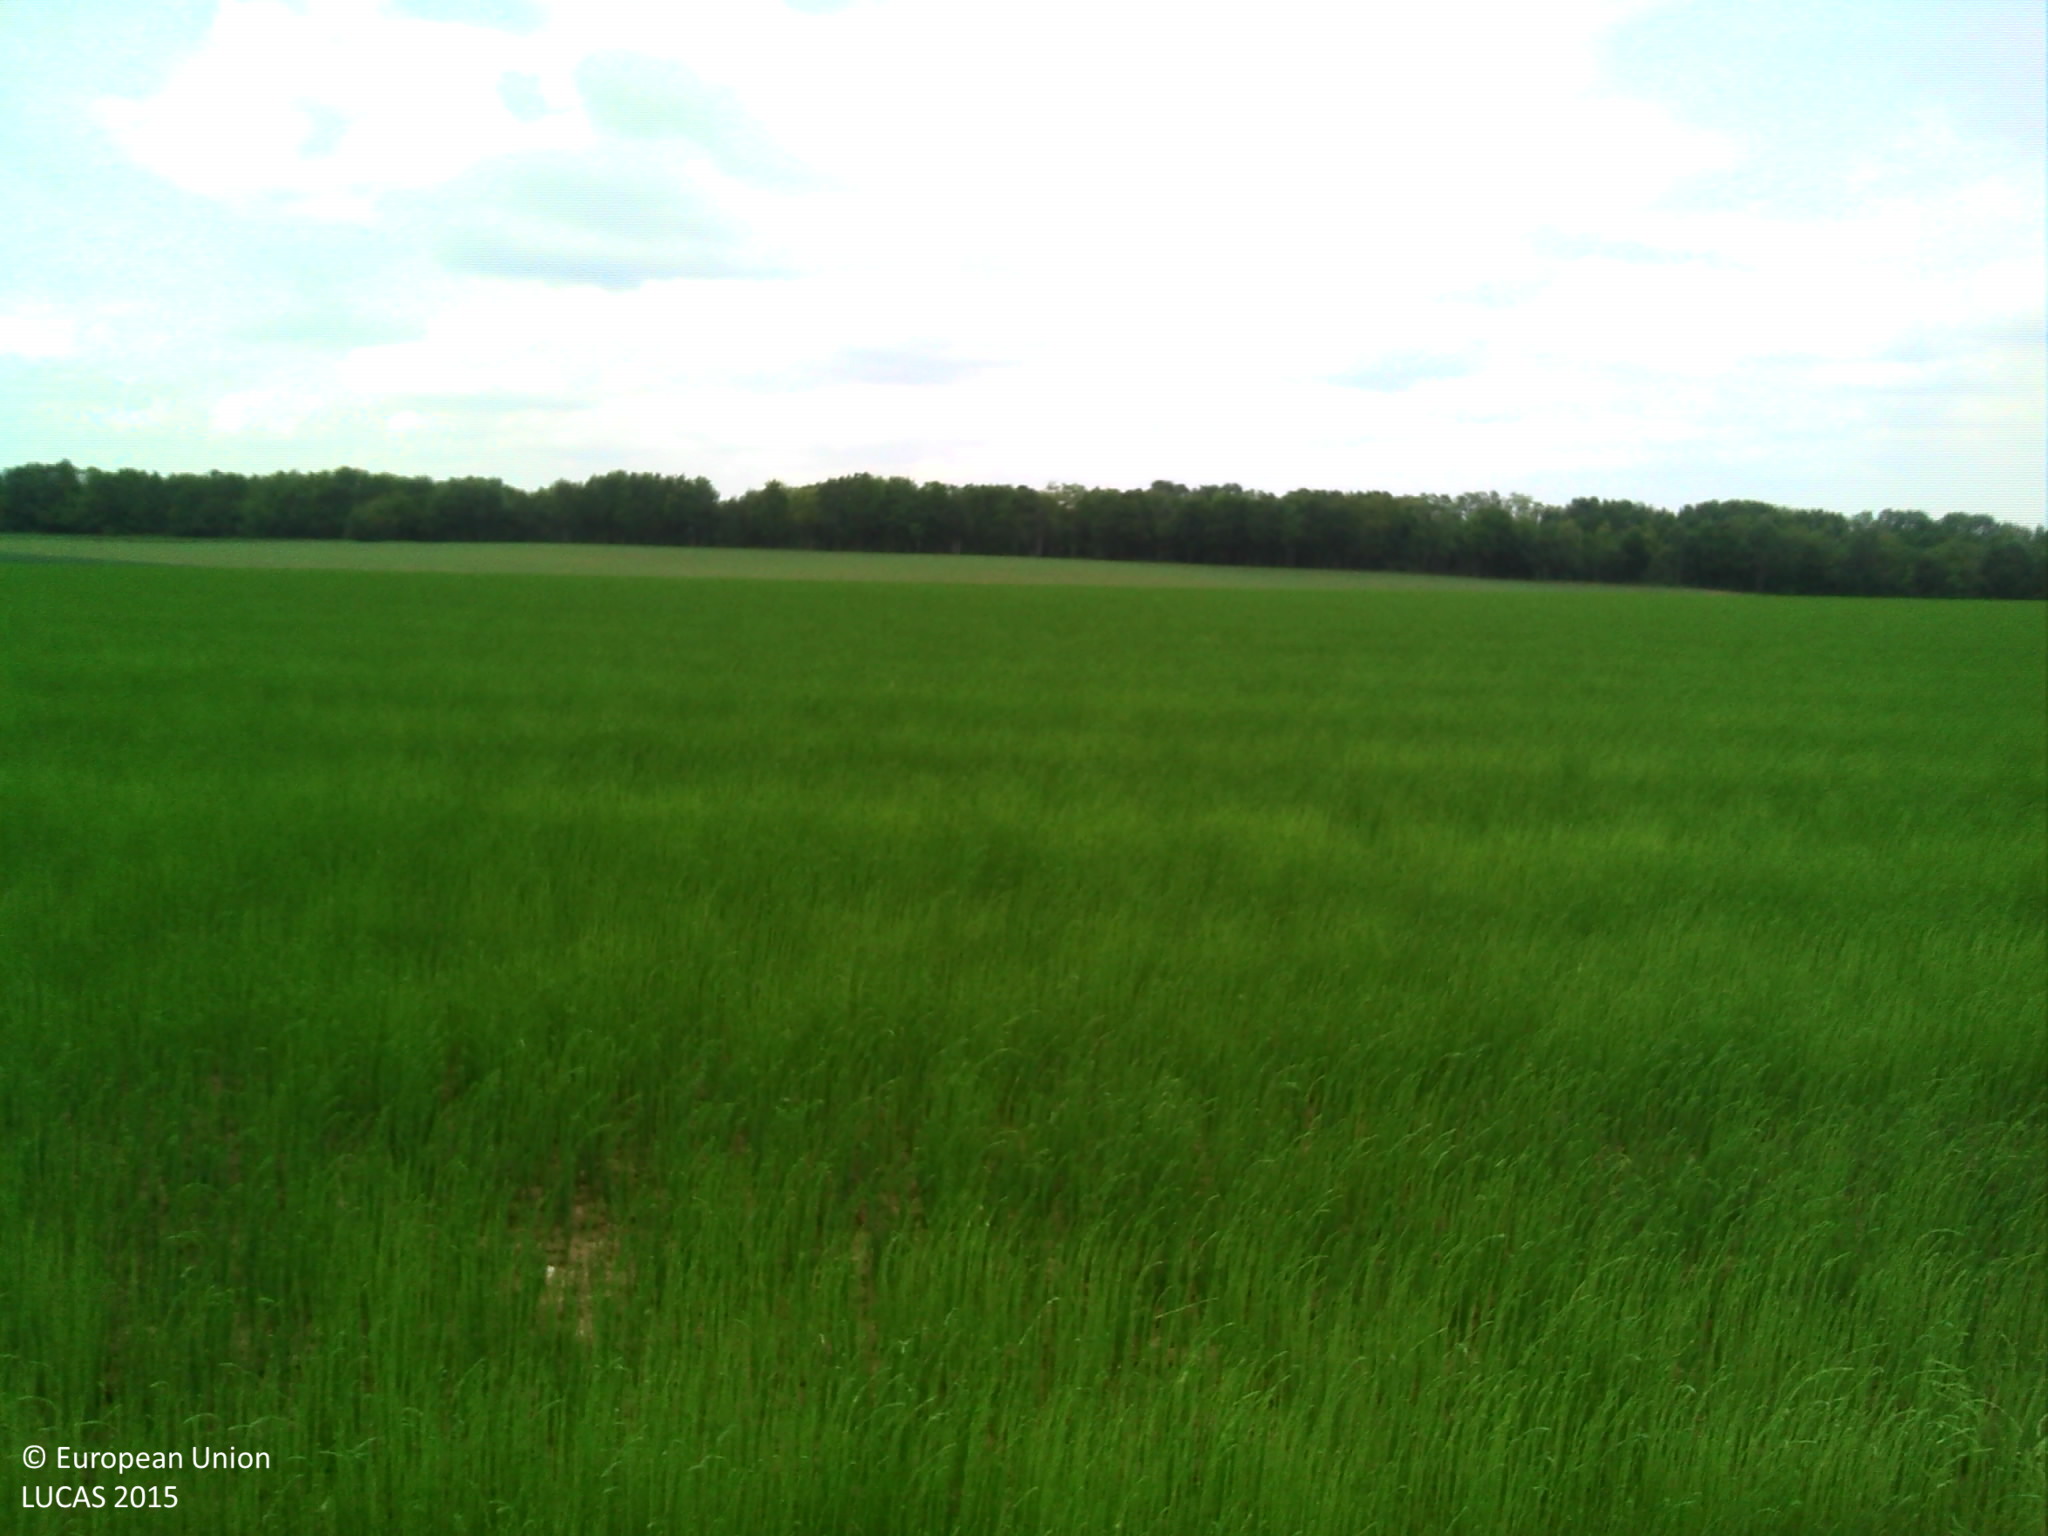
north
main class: Cropland
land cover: Other fibre and oleaginous crops
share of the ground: > 75 %
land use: Agriculture (excluding fallow land and kitchen gardens)
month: May
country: BE
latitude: 50.6557
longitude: 4.3231
